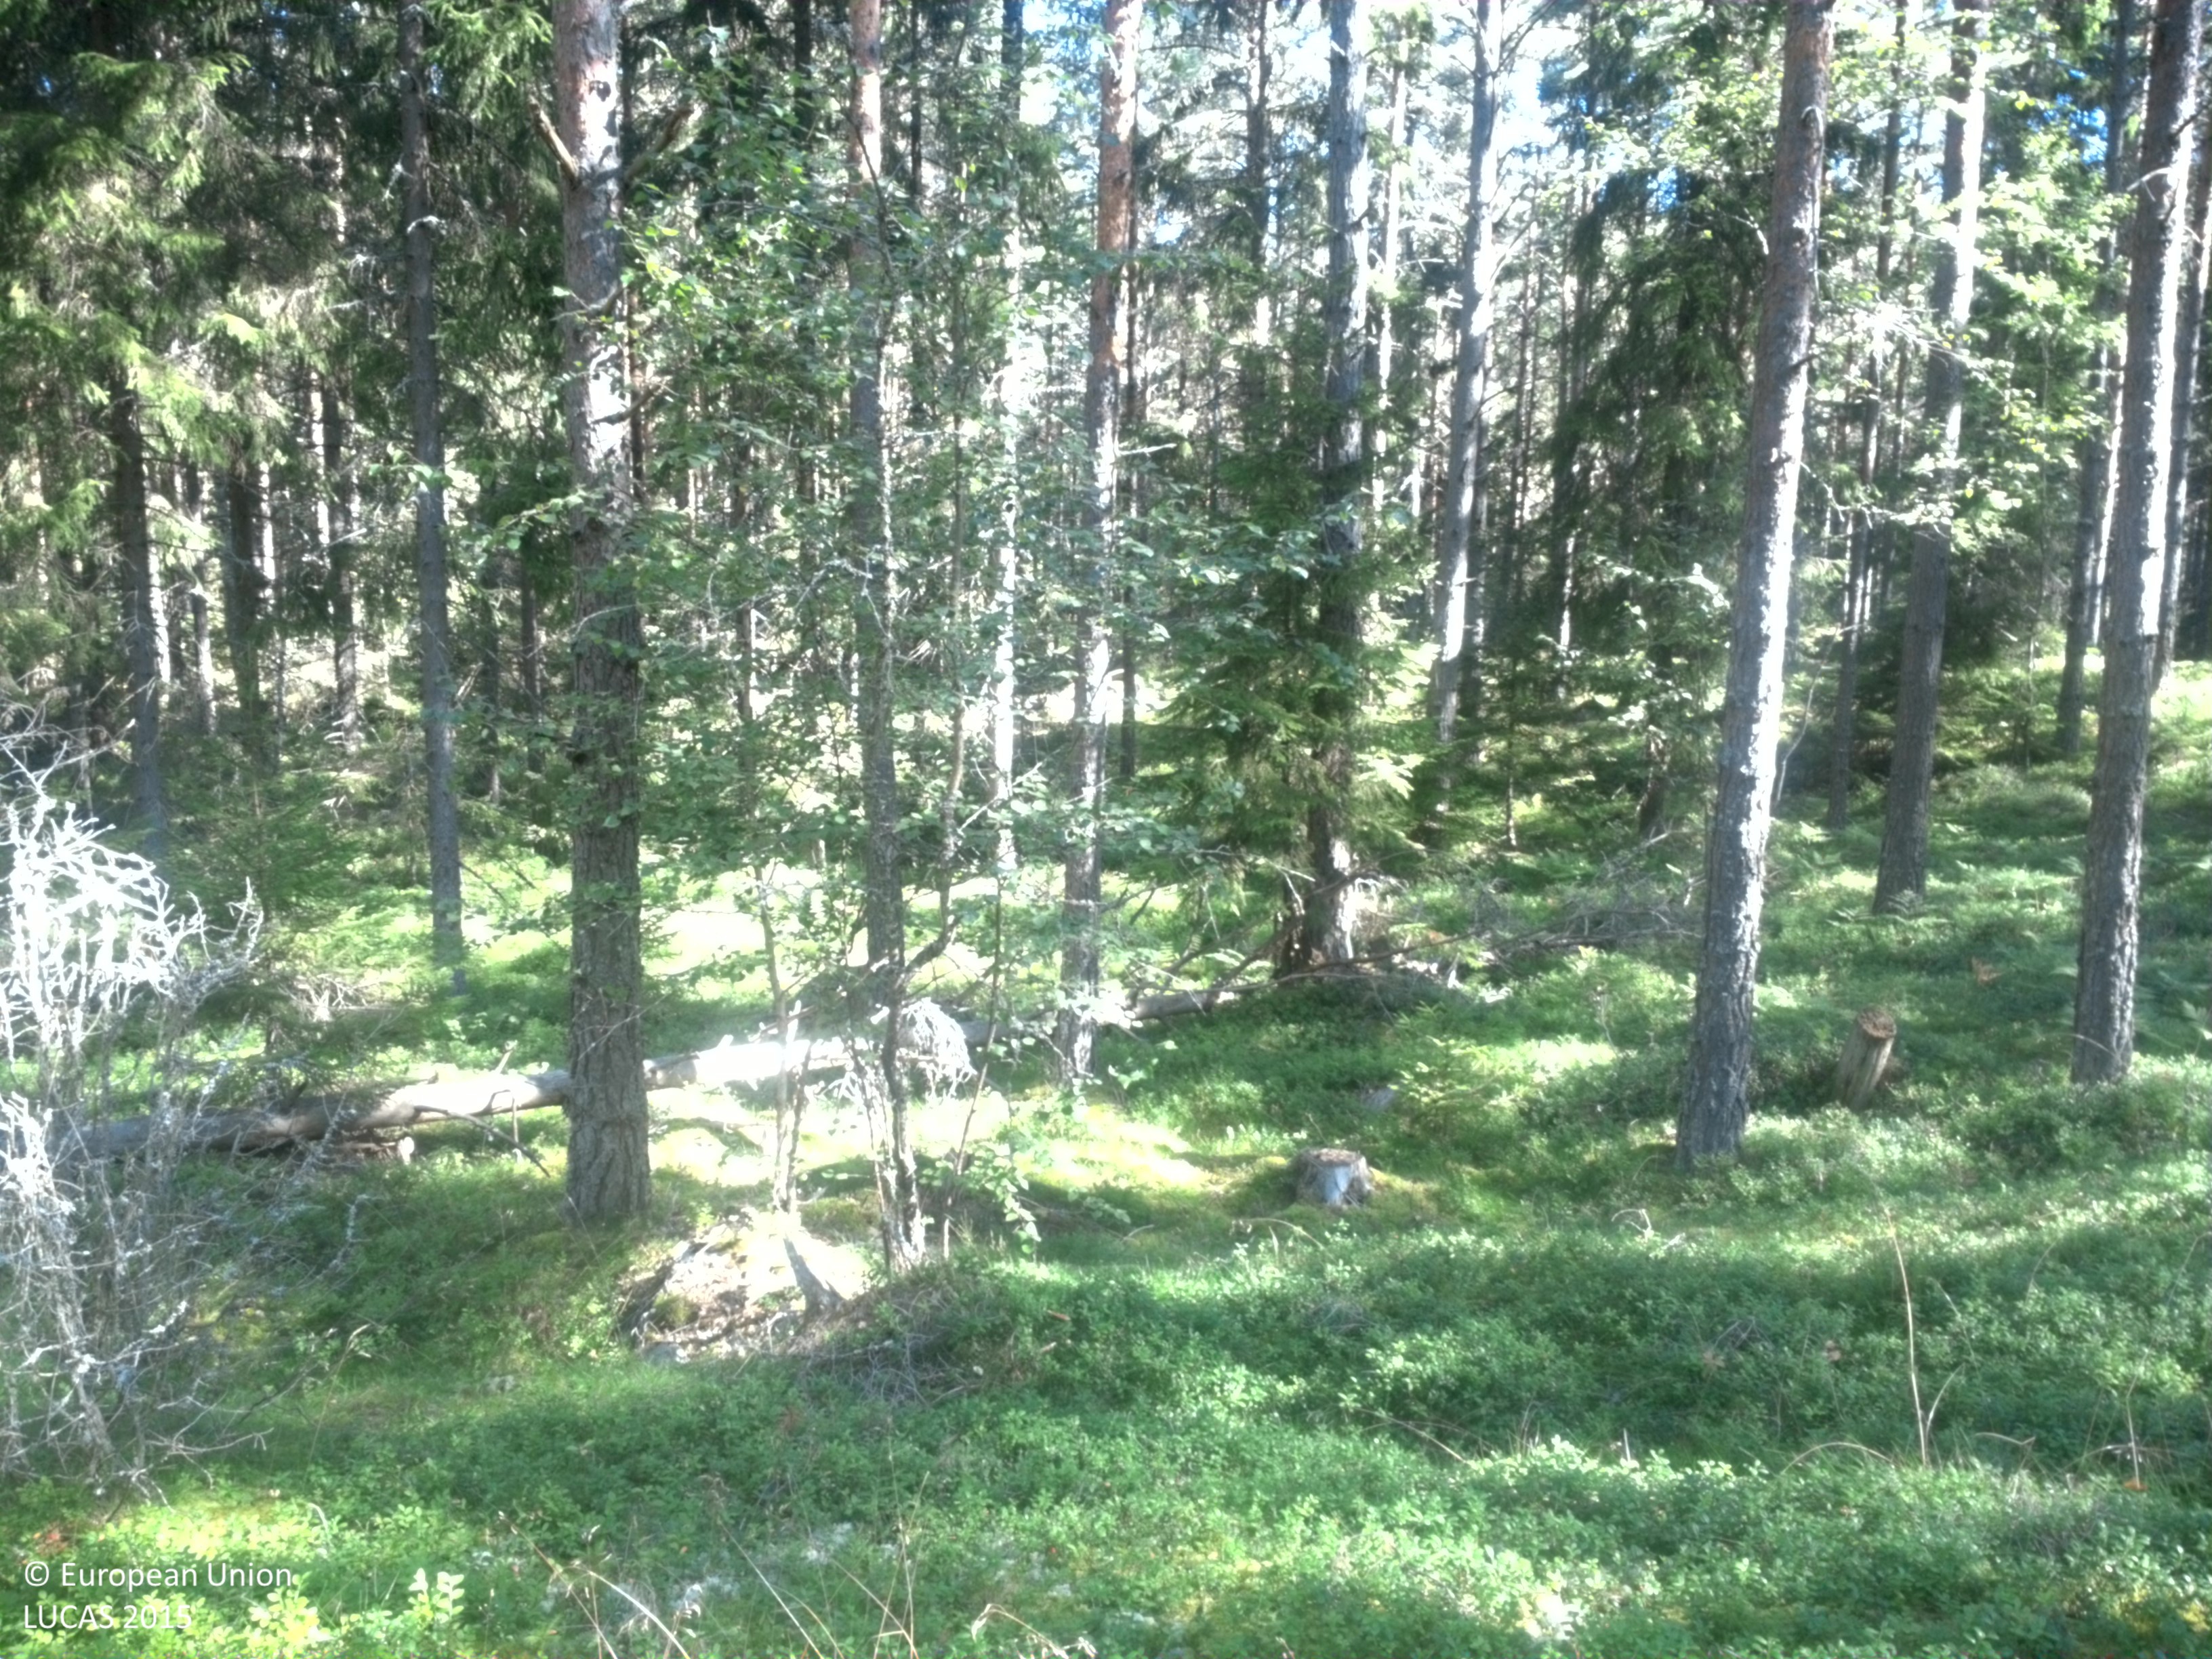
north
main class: Woodland
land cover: Pine dominated coniferous woodland
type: boreal forest
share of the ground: 50 - 75 %
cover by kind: coniferous forest trees 70 %, shrubs 25 %, lichens and mosses 5 %
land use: Forestry
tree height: > 5 m
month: August
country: SE
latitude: 59.7651
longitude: 17.1325
